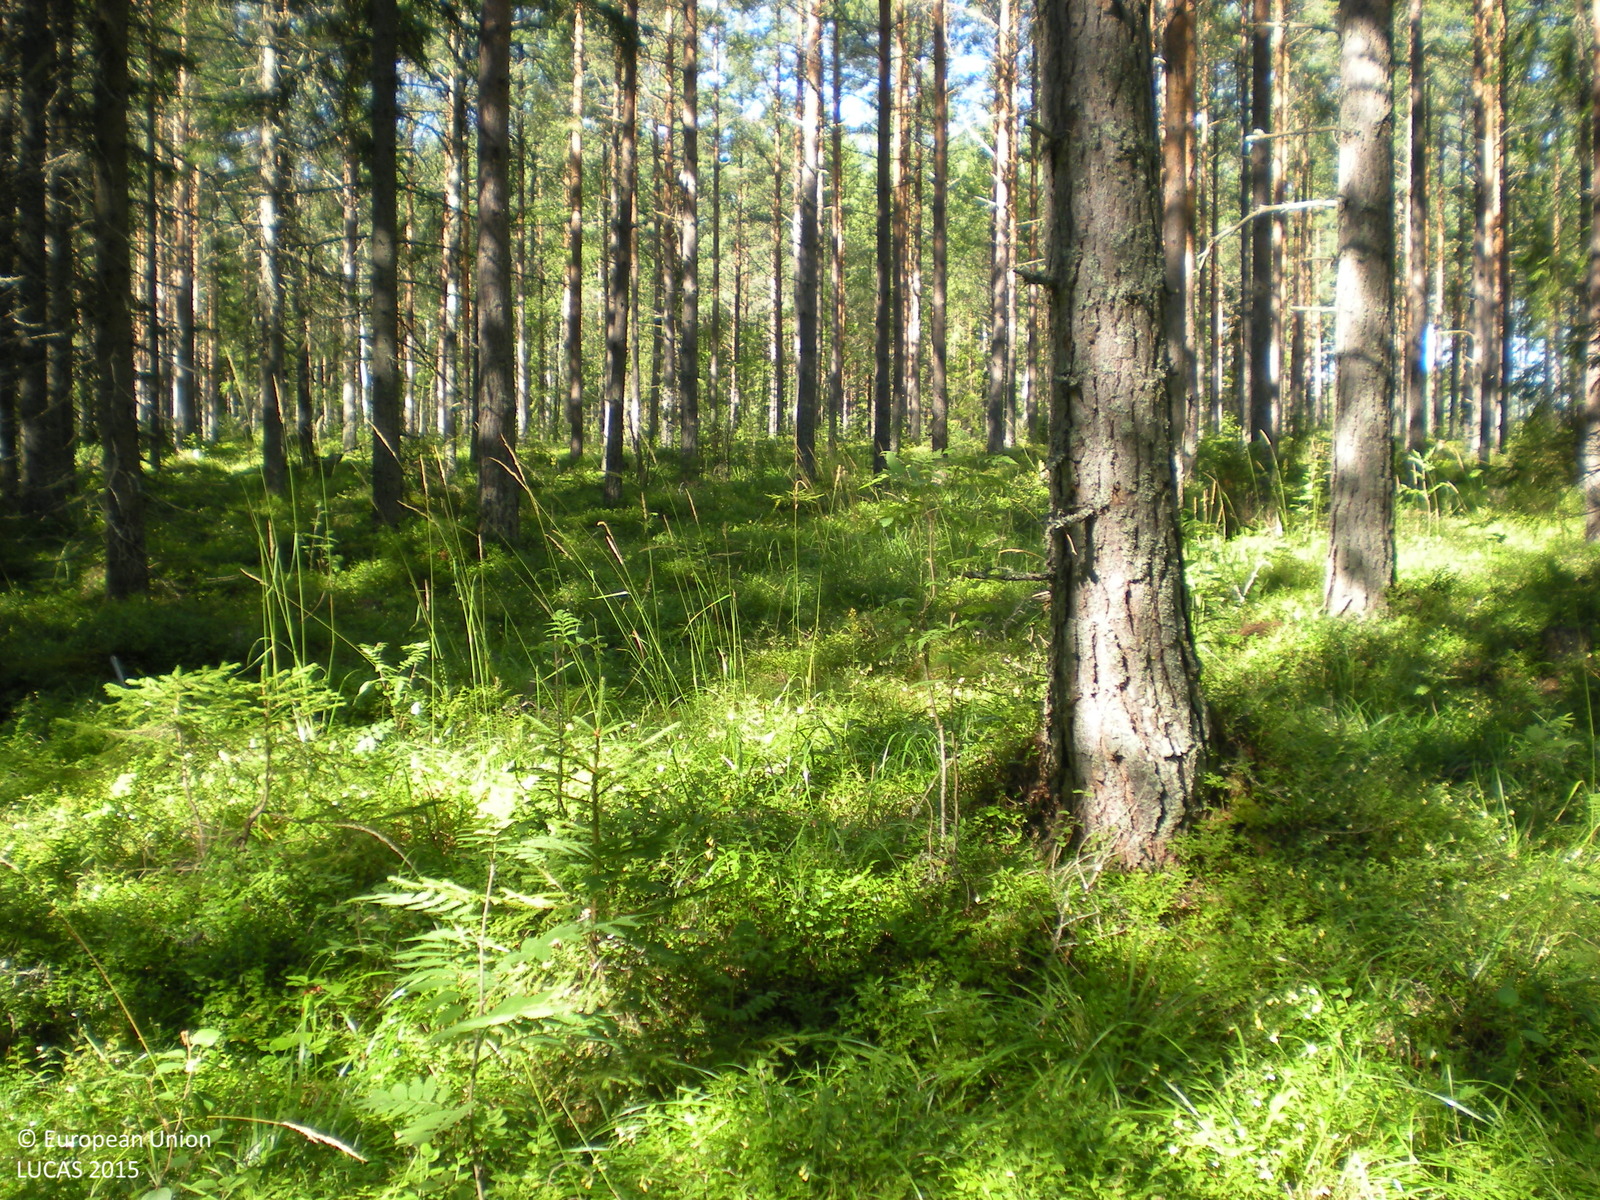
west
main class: Woodland
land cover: Pine dominated coniferous woodland
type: boreal forest
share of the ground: 50 - 75 %
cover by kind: coniferous forest trees 60 %, shrubs 20 %, broadleaved forest trees 10 %, herbaceous plants 5 %, lichens and mosses 5 %
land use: Forestry
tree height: > 5 m
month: August
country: SE
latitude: 60.7601
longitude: 17.1278
